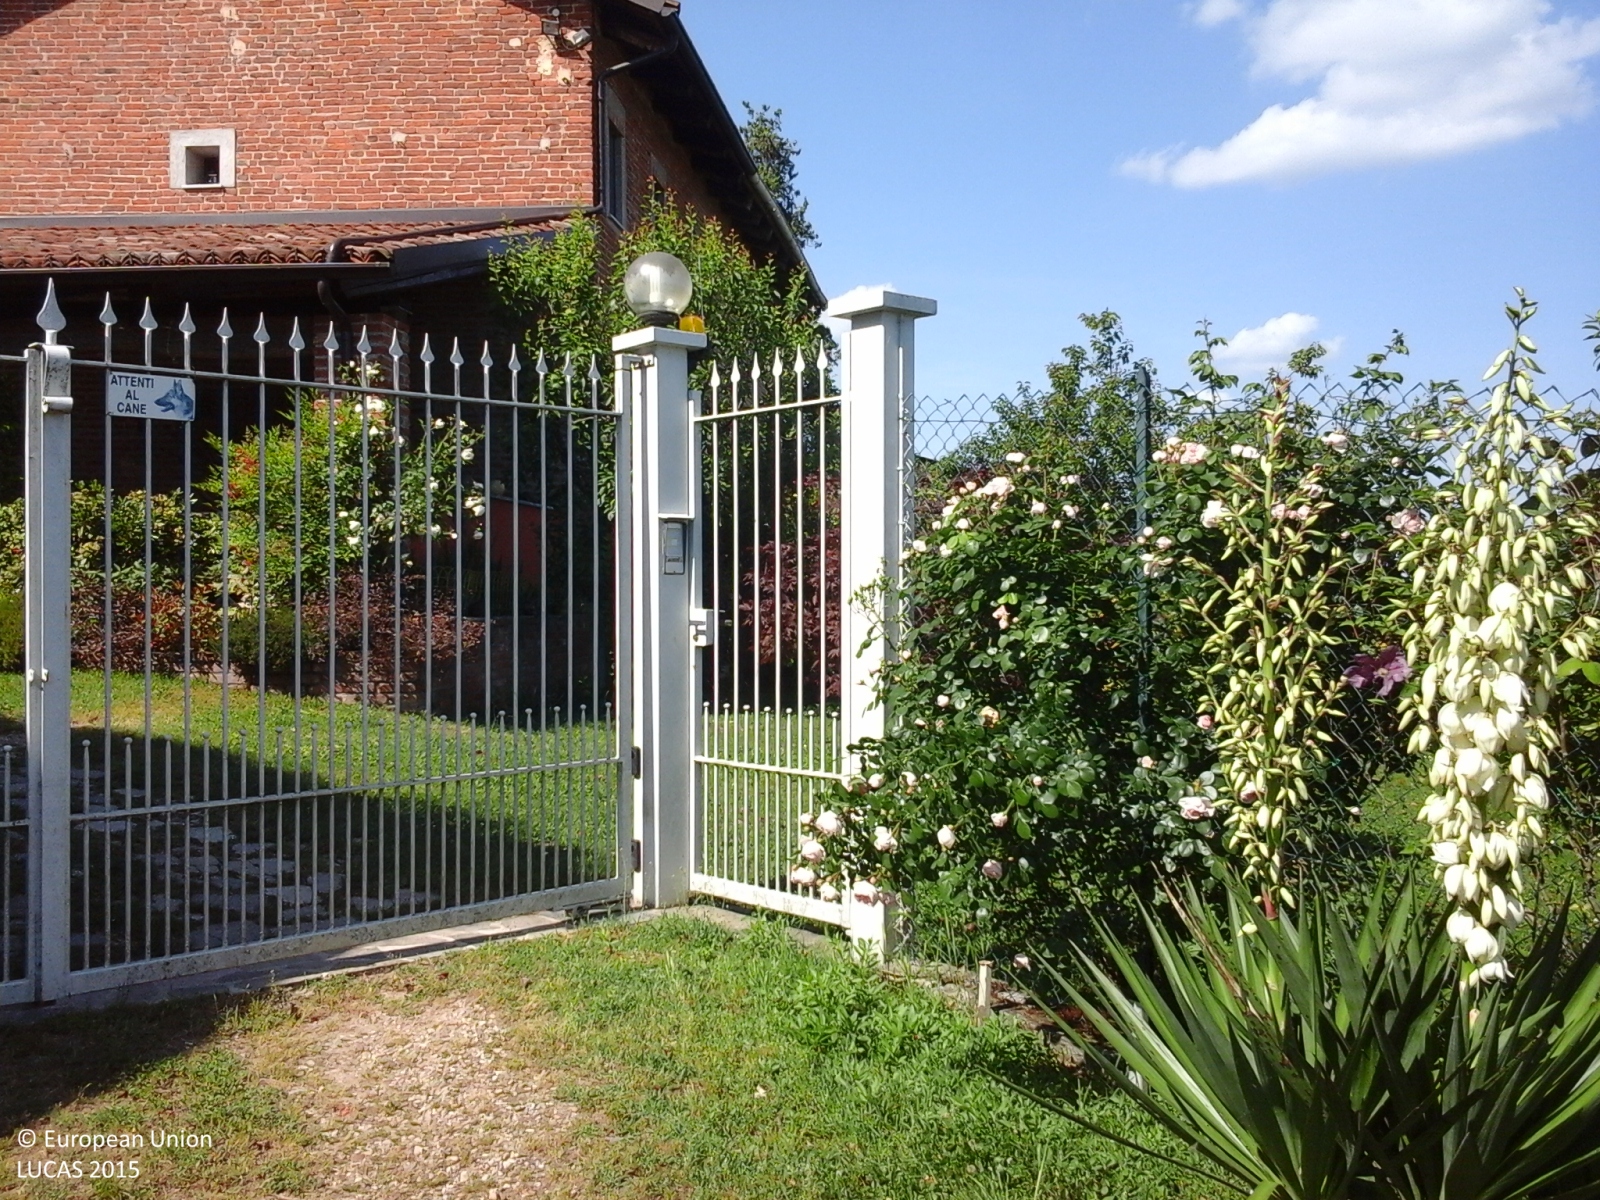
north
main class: Woodland
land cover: Broadleaved woodland
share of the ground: 25 - 50 %
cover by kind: broadleaved forest trees 85 %, herbaceous plants 15 %
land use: Residential
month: May
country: IT
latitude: 44.9263
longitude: 7.9893
